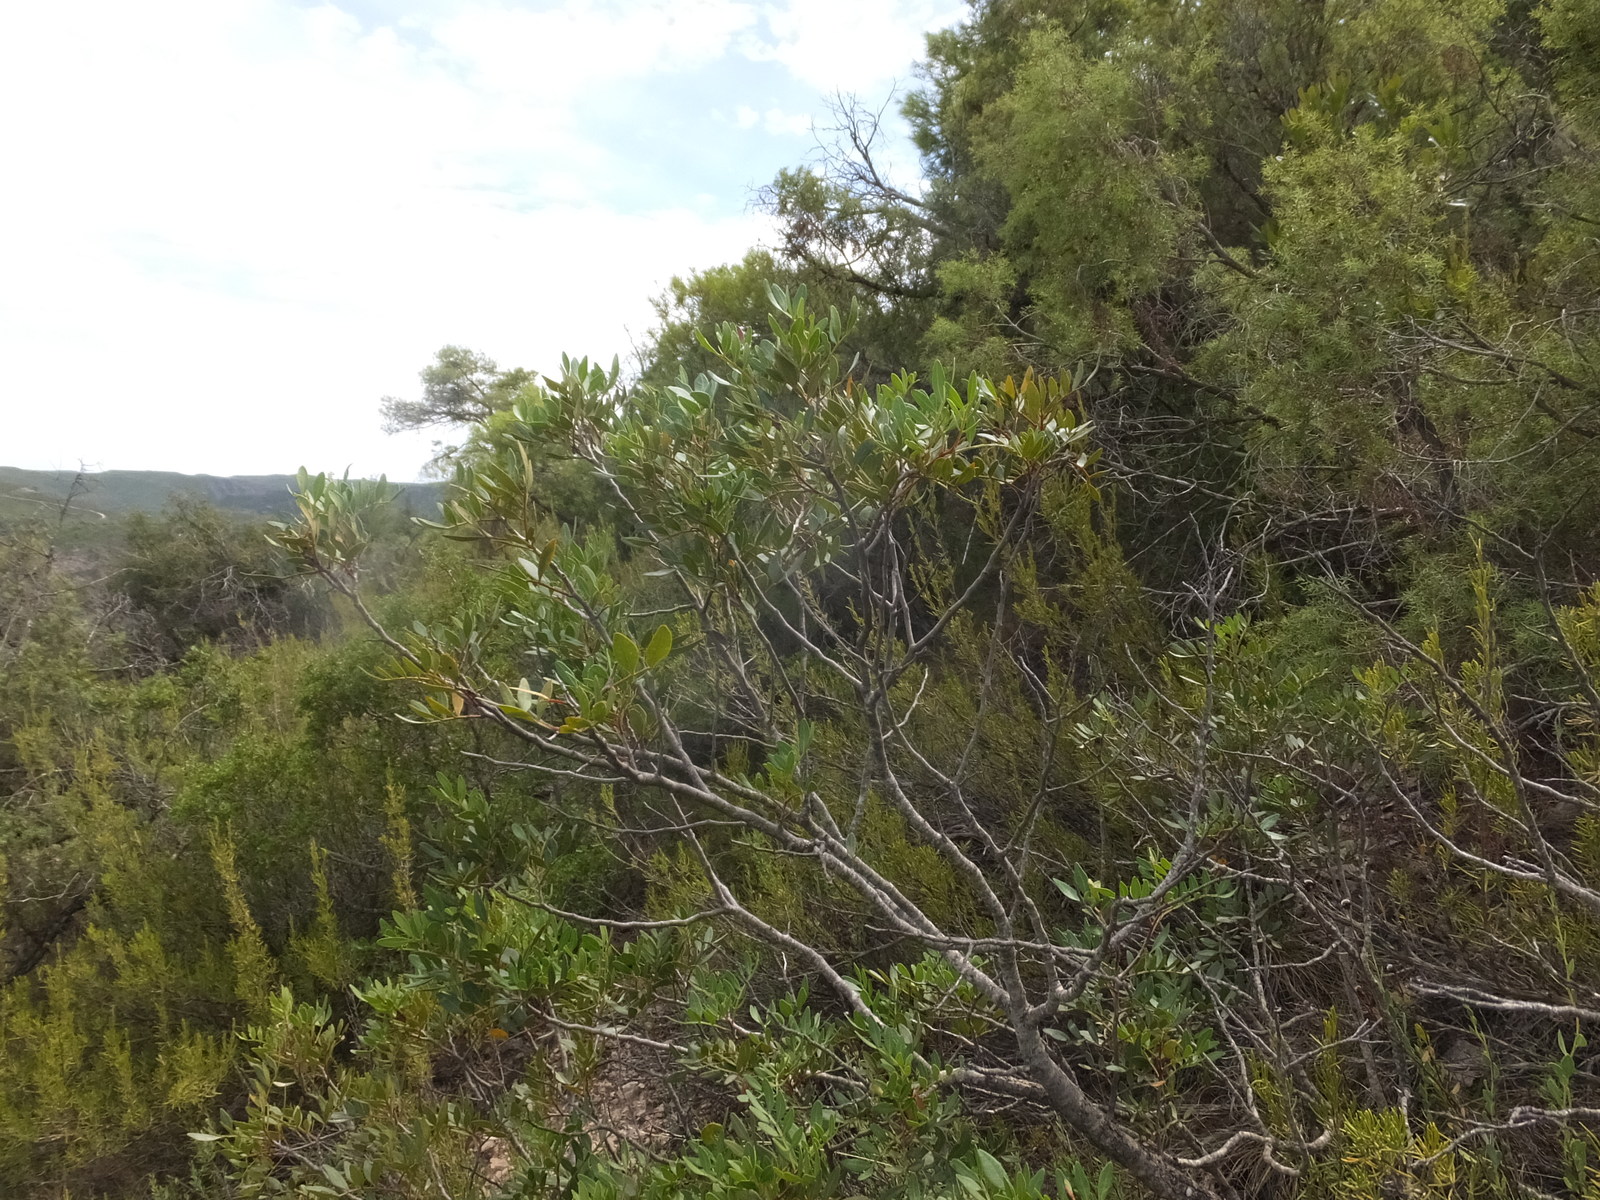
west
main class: Woodland
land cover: Pine dominated mixed woodland
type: coniferous forest of the mediterranean region
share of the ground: 50 - 75 %
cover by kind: coniferous forest trees 60 %, broadleaved forest trees 20 %, shrubs 20 %
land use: Forestry
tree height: > 5 m
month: August
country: ES
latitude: 41.2407
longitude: 0.2884
